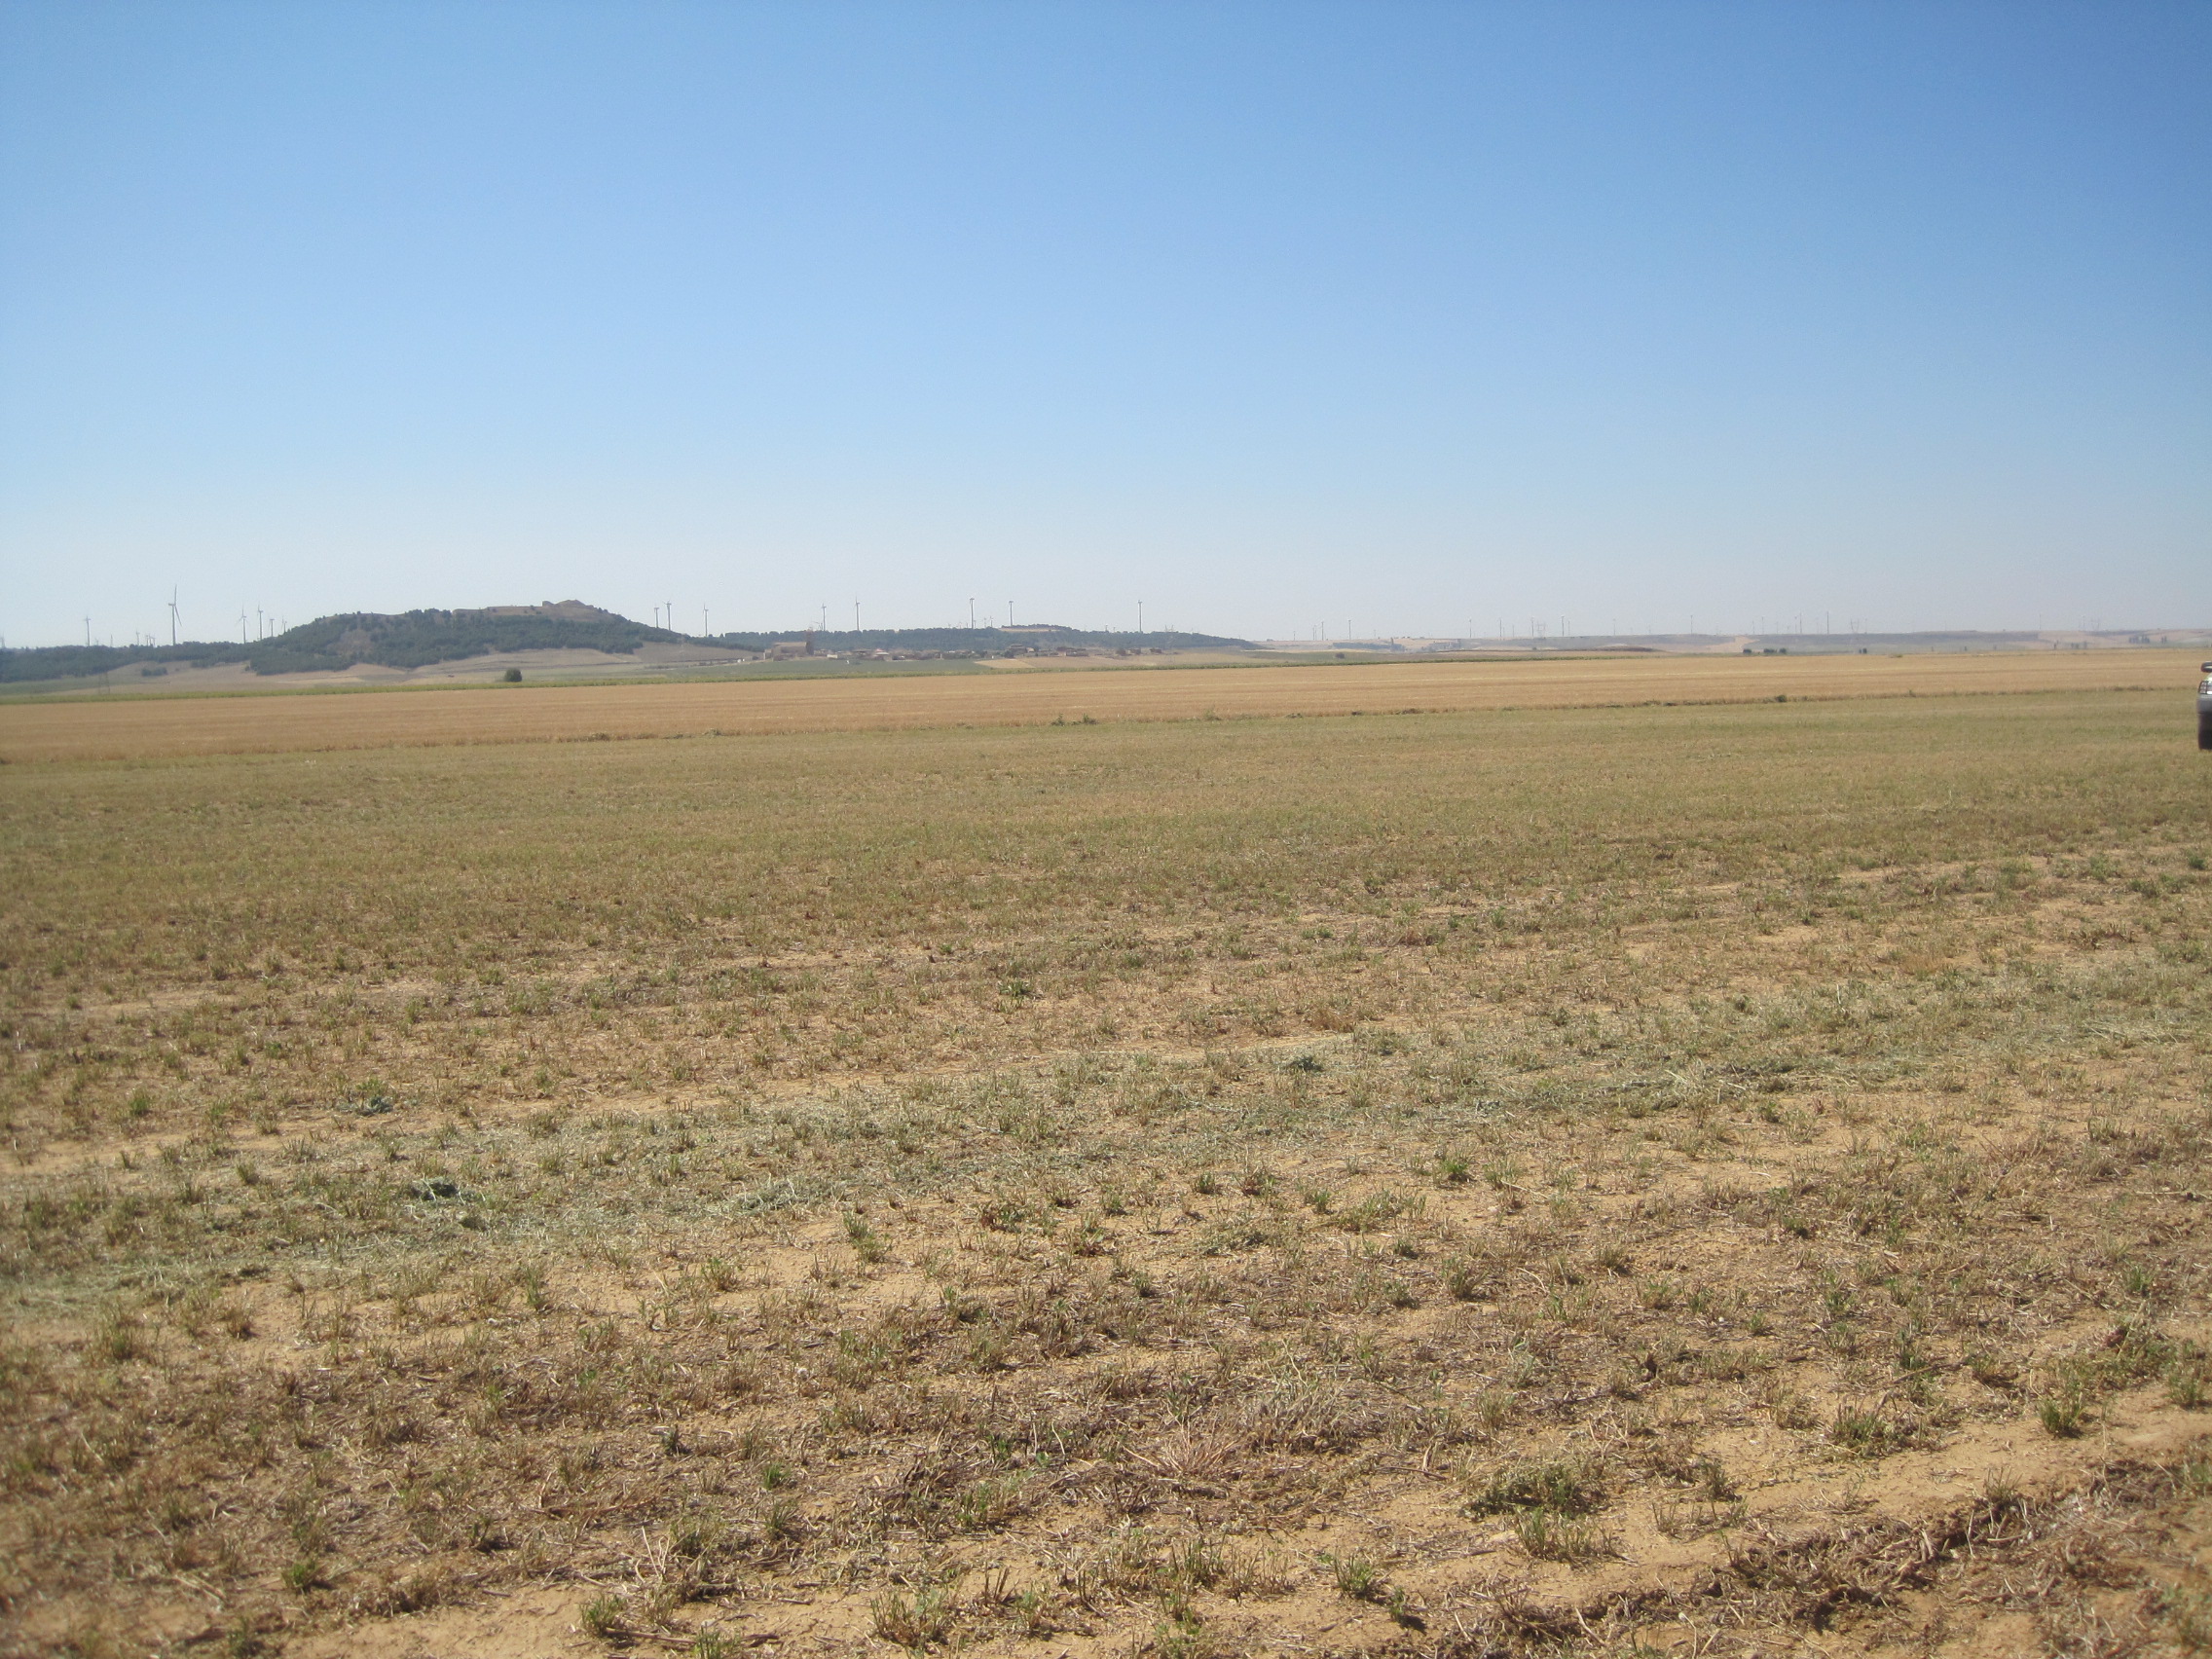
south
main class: Cropland
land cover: Lucerne
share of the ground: 10 - 25 %
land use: Agriculture (excluding fallow land and kitchen gardens)
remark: Harvested field
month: July
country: ES
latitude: 41.9834
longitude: -4.7873
